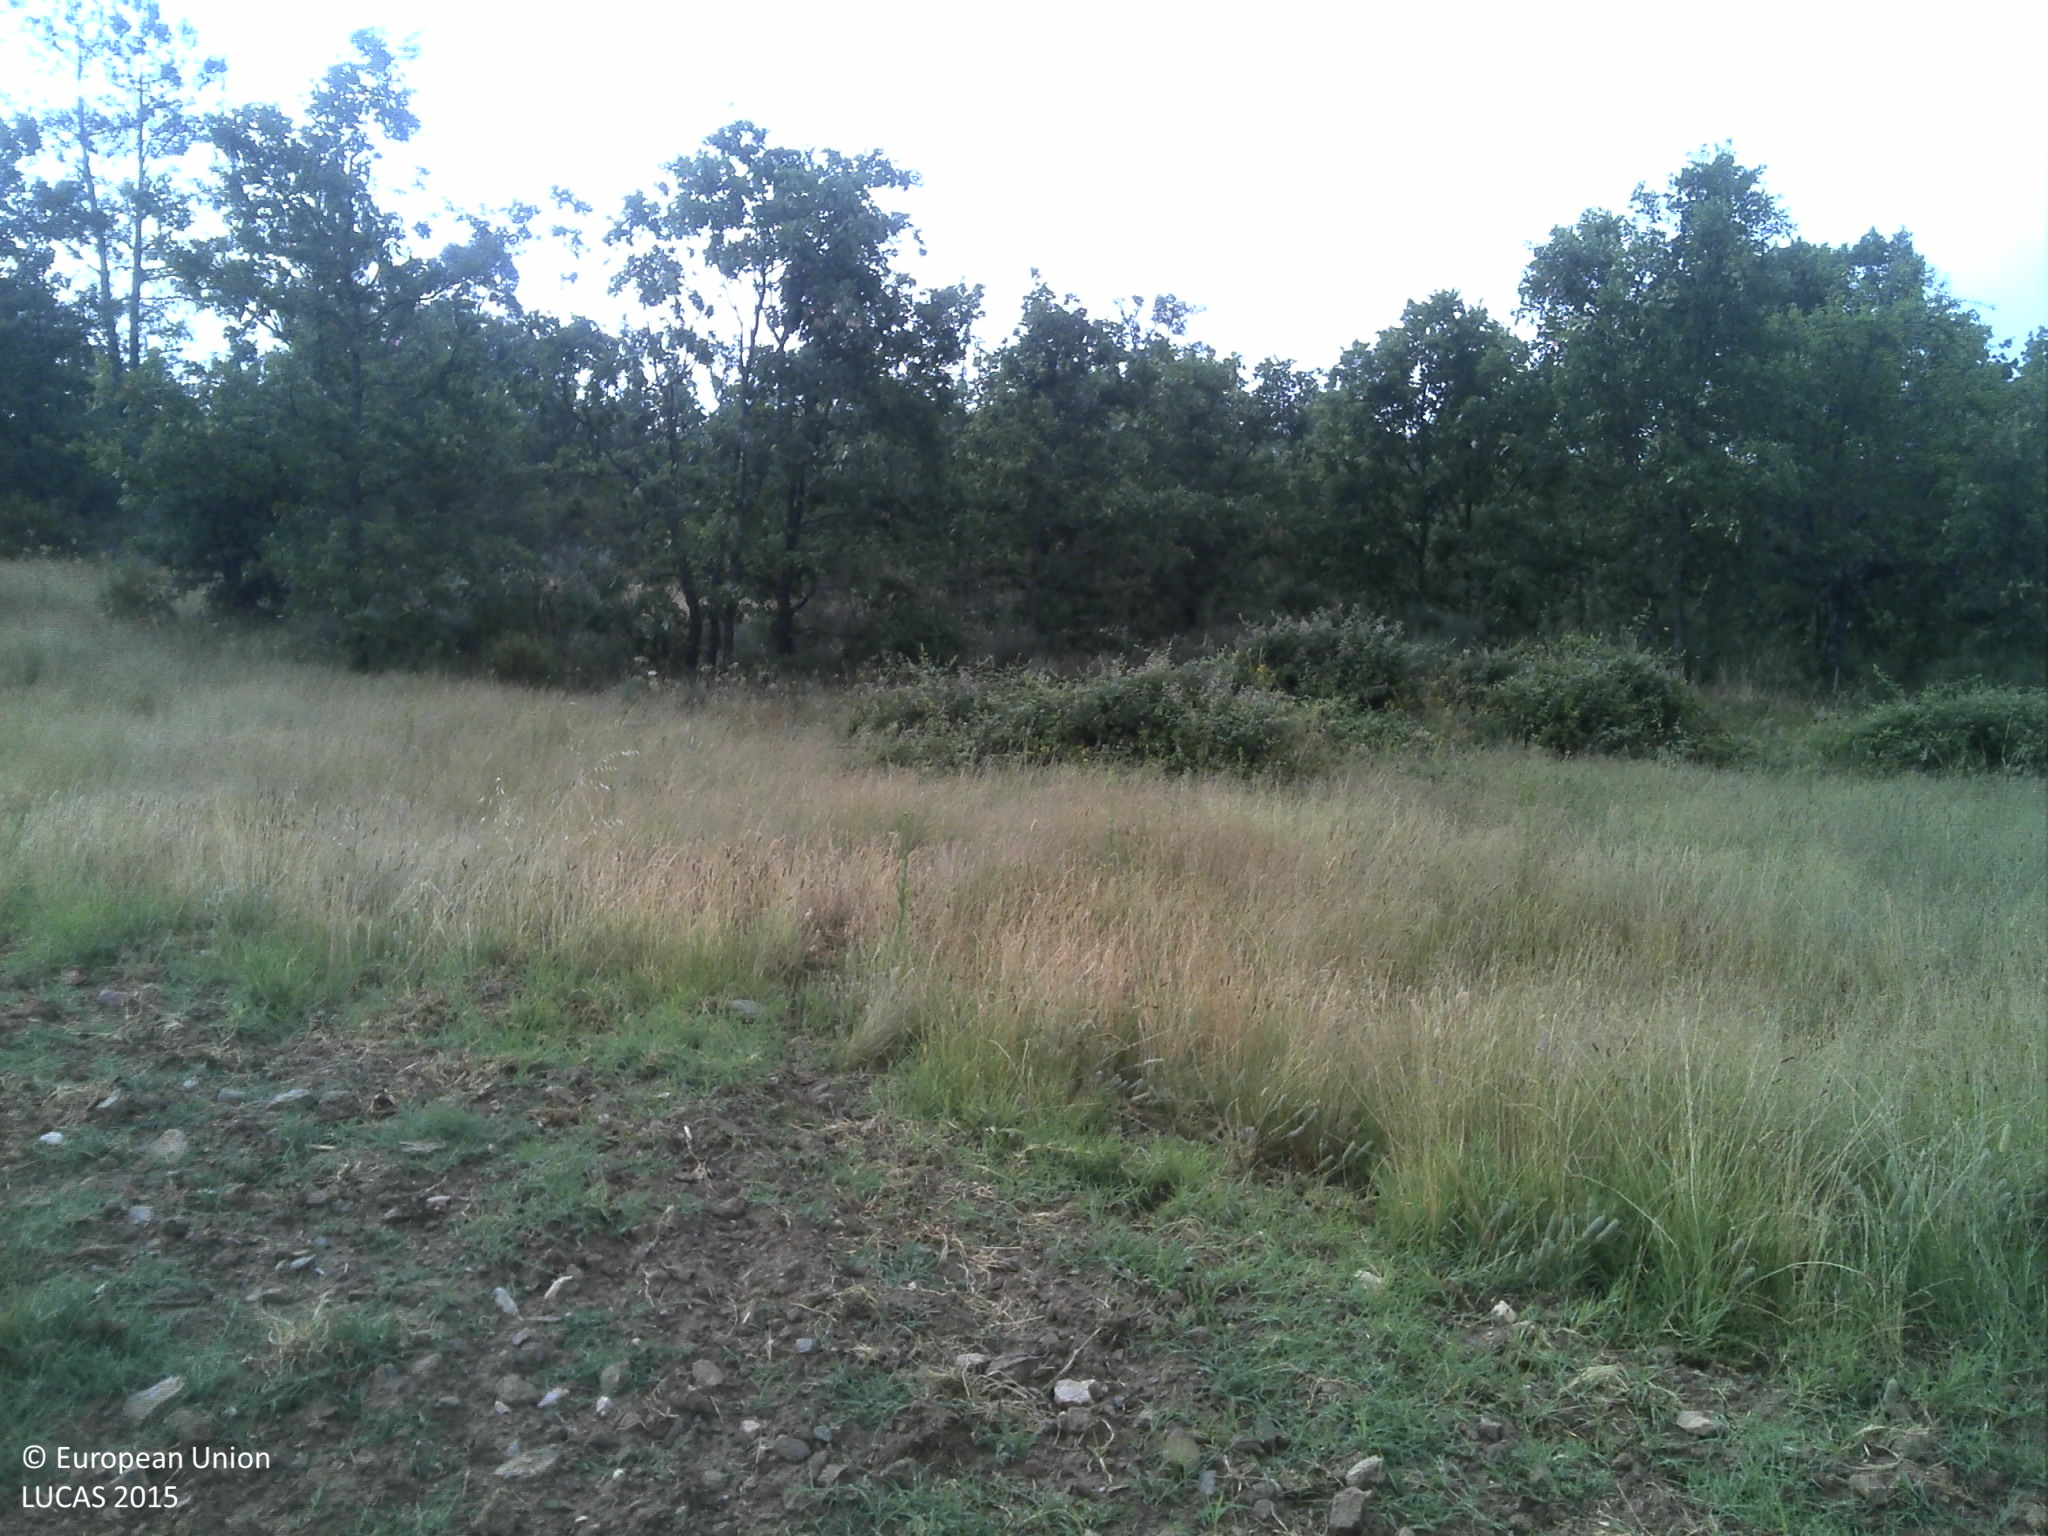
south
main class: Cropland
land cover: Maize
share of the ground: 10 - 25 %
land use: Agriculture (excluding fallow land and kitchen gardens)
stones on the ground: 10 - 25 %
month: June
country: PT
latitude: 40.1927
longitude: -7.4058
